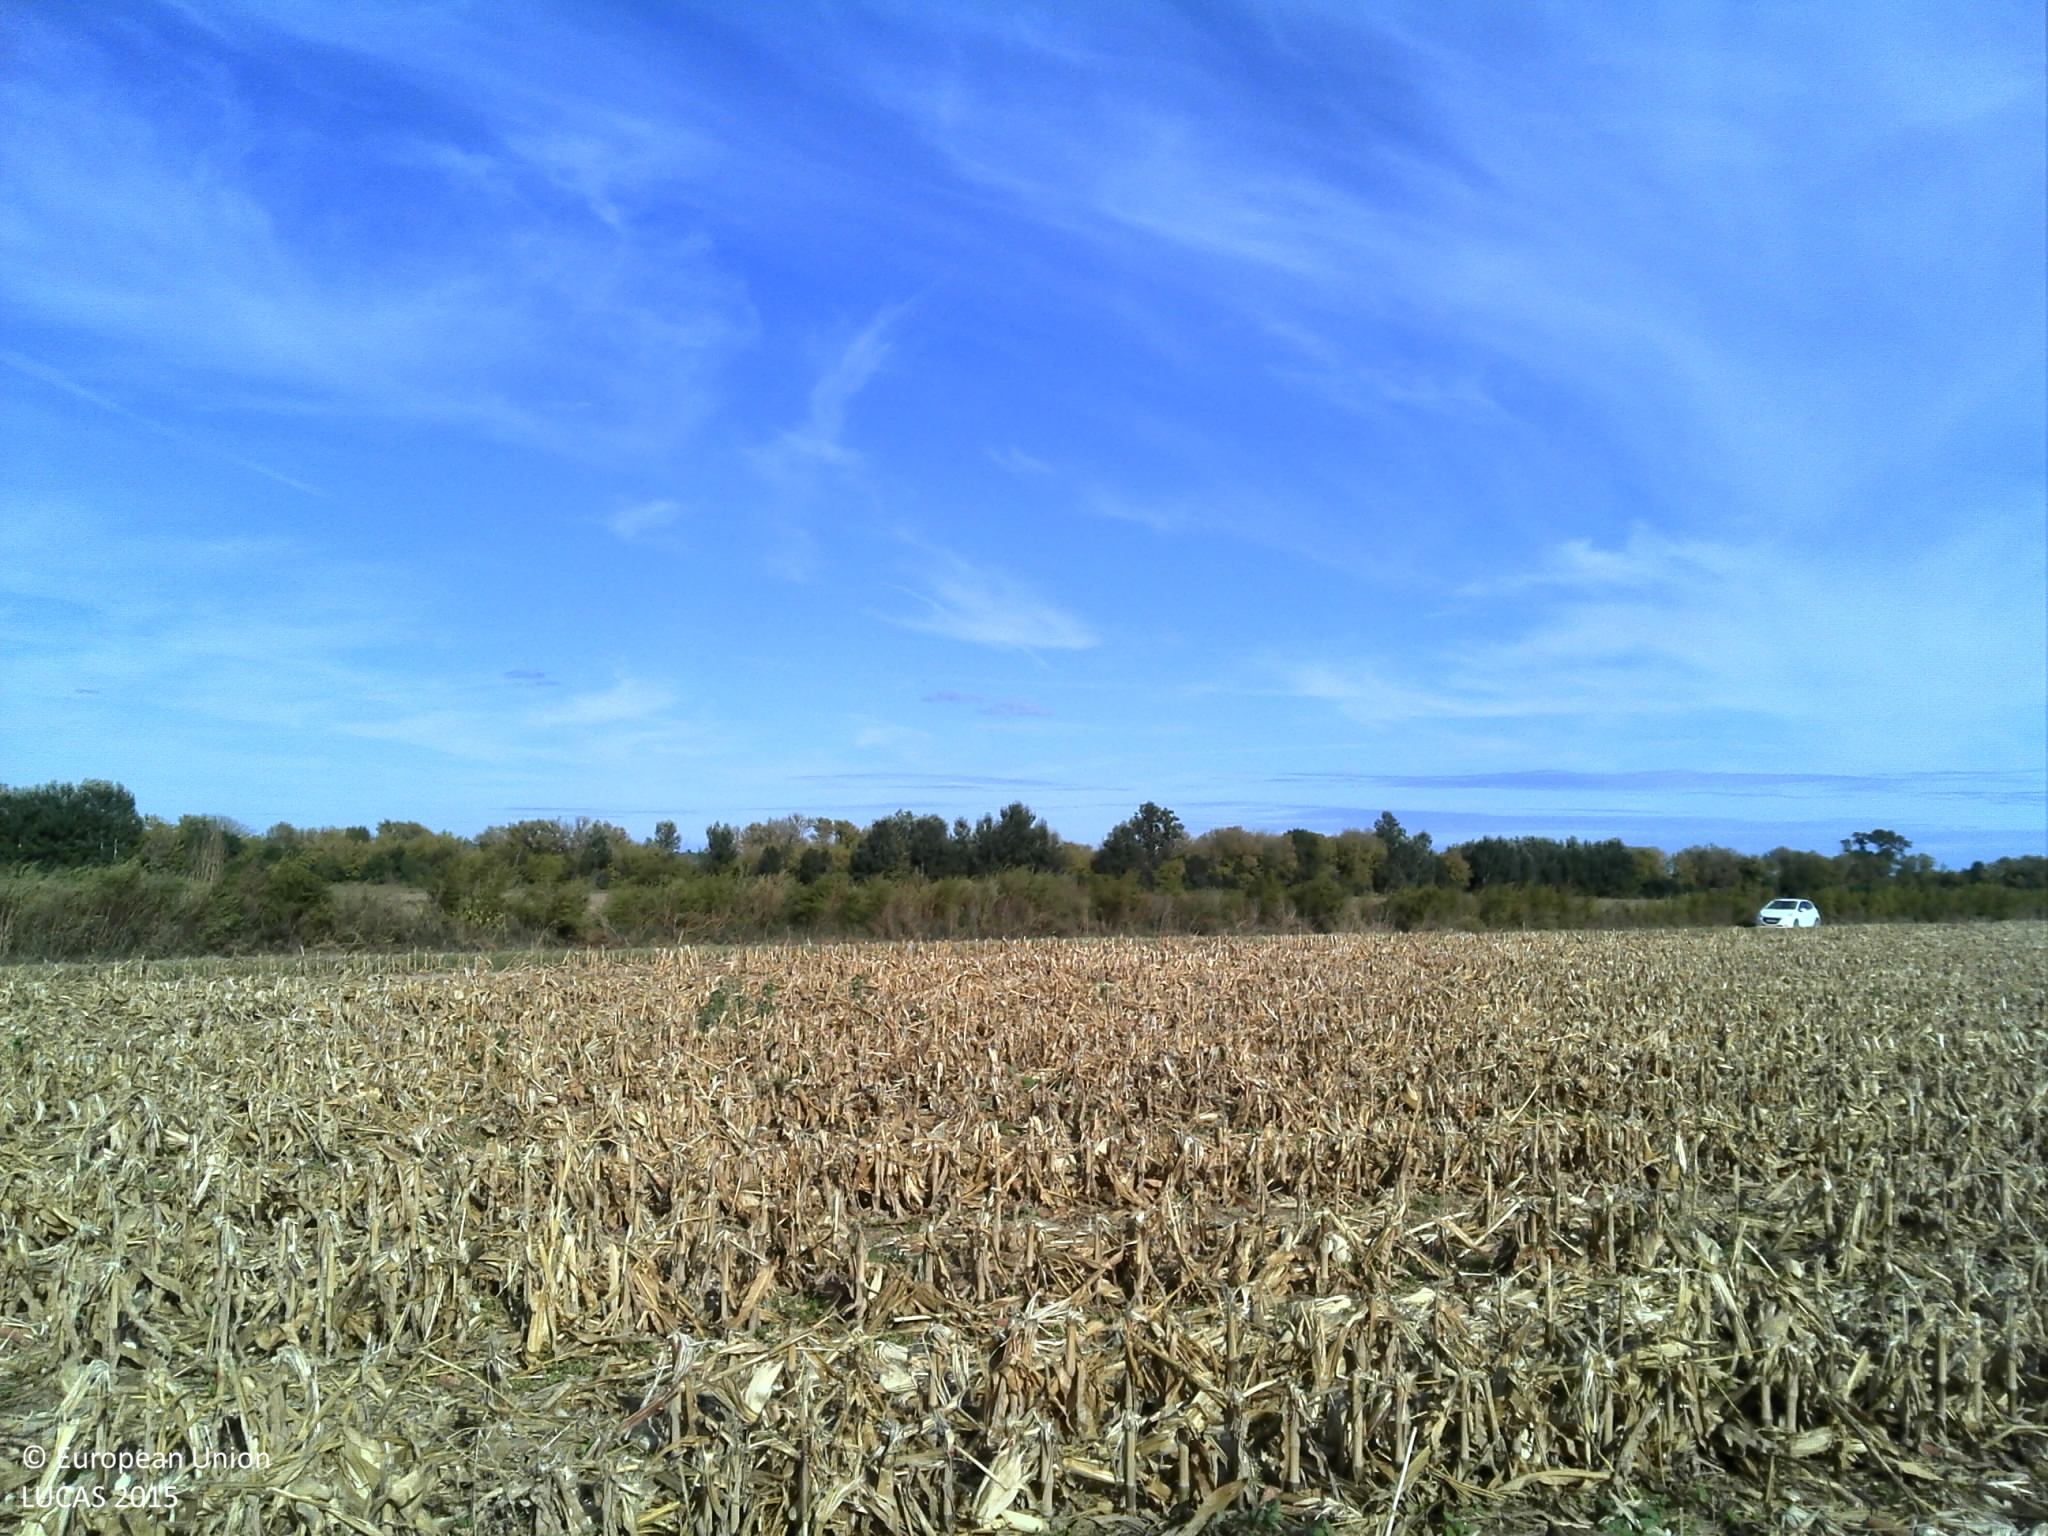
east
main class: Cropland
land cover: Maize
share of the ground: 50 - 75 %
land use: Agriculture (excluding fallow land and kitchen gardens)
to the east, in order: Maize; Grass margins; Tracks; Managed hedges; Other bare soil
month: October
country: FR
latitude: 43.4002
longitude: 3.4285
